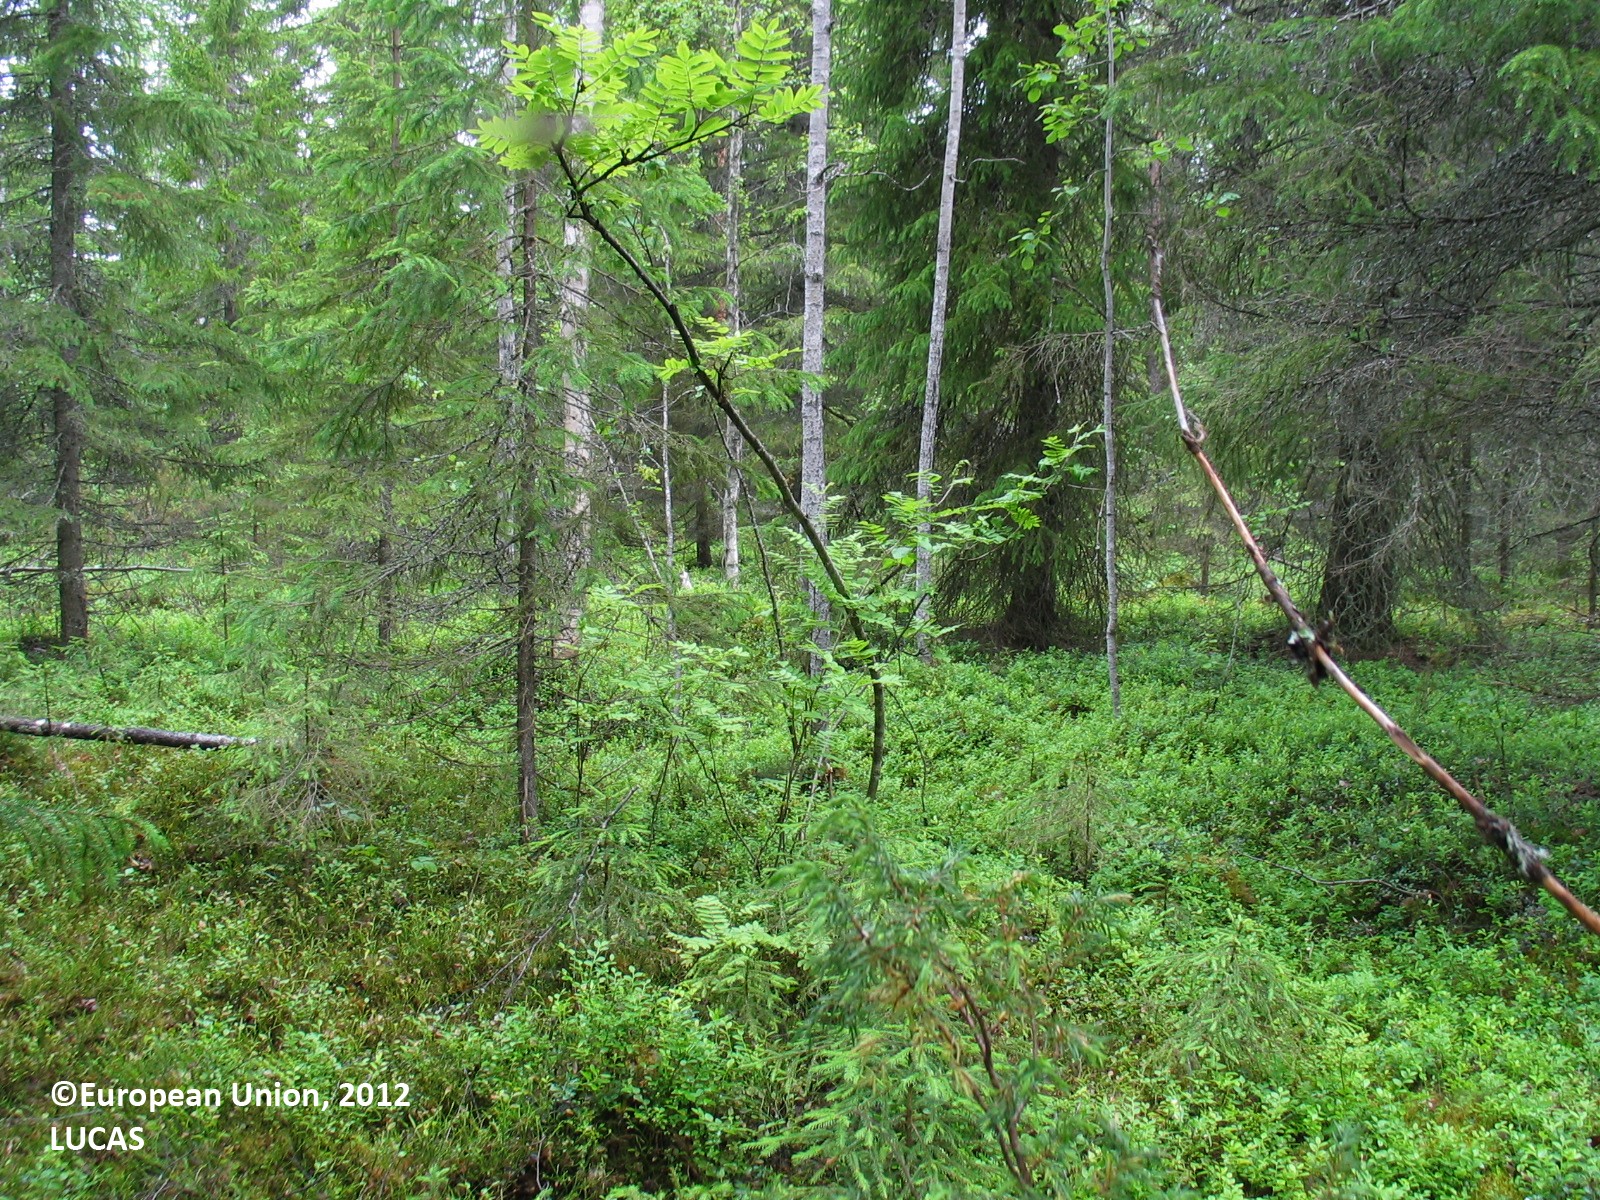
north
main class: Woodland
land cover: Spruce dominated coniferous woodland
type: boreal forest
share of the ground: 50 - 75 %
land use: Forestry
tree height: > 5 m
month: July
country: FI
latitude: 65.9839
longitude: 25.0571
